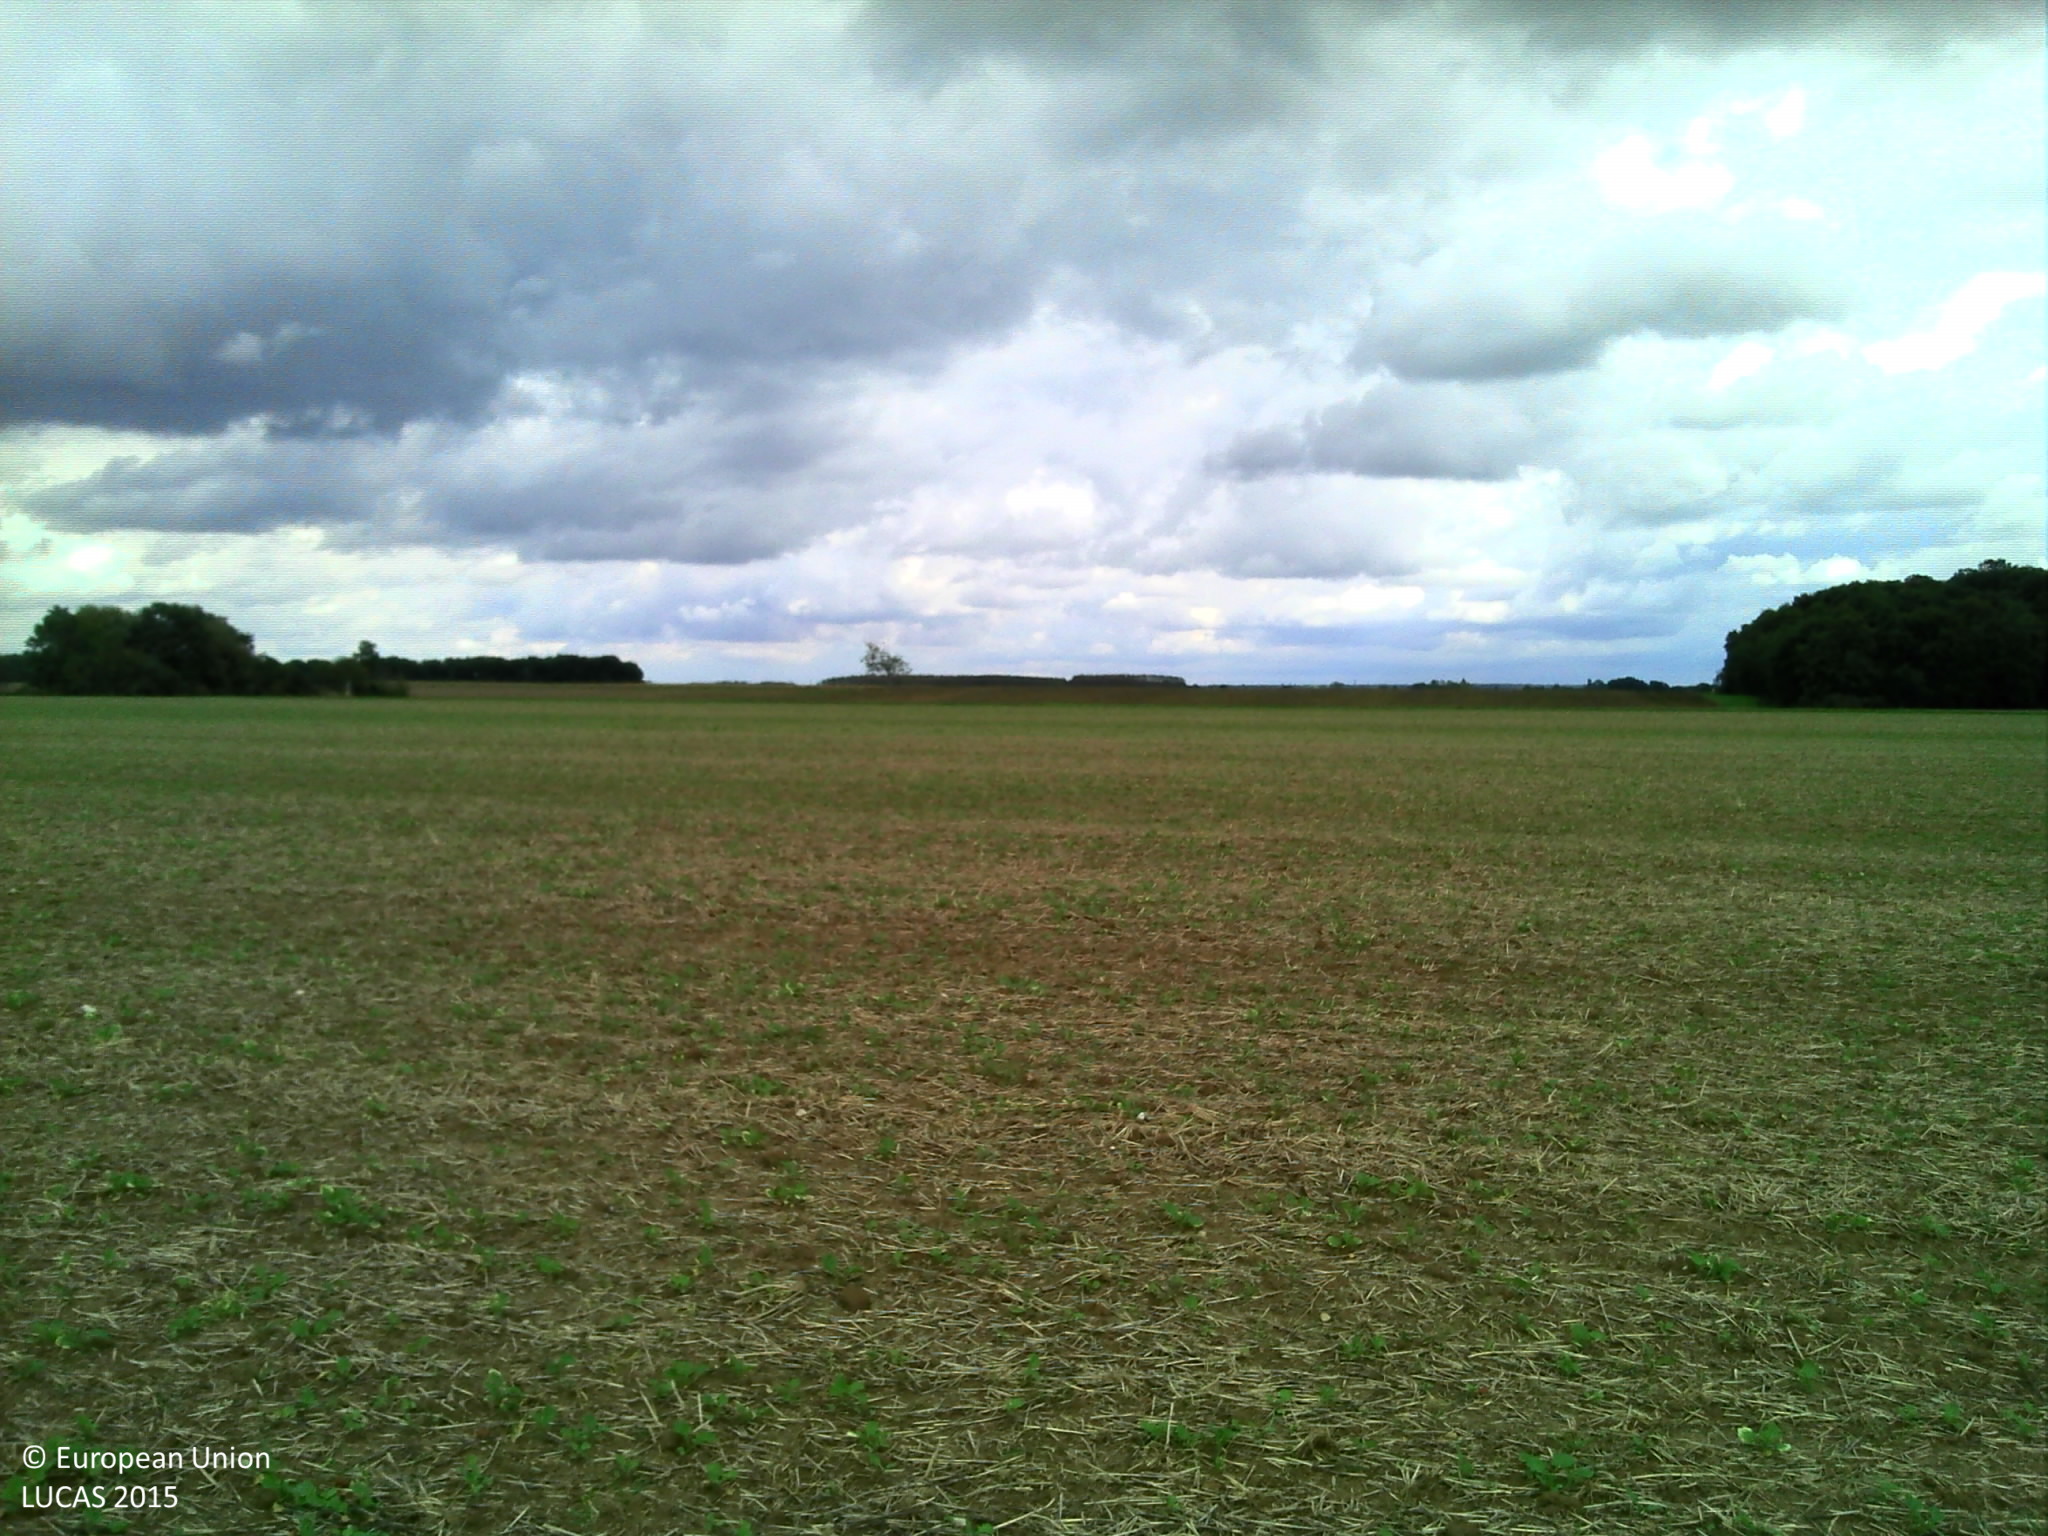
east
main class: Cropland
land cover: Other fibre and oleaginous crops
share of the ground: 10 - 25 %
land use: Agriculture (excluding fallow land and kitchen gardens)
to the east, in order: Other fibre and oleaginous crops; Tracks; Other bare soil
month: September
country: FR
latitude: 46.9713
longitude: 4.9406
